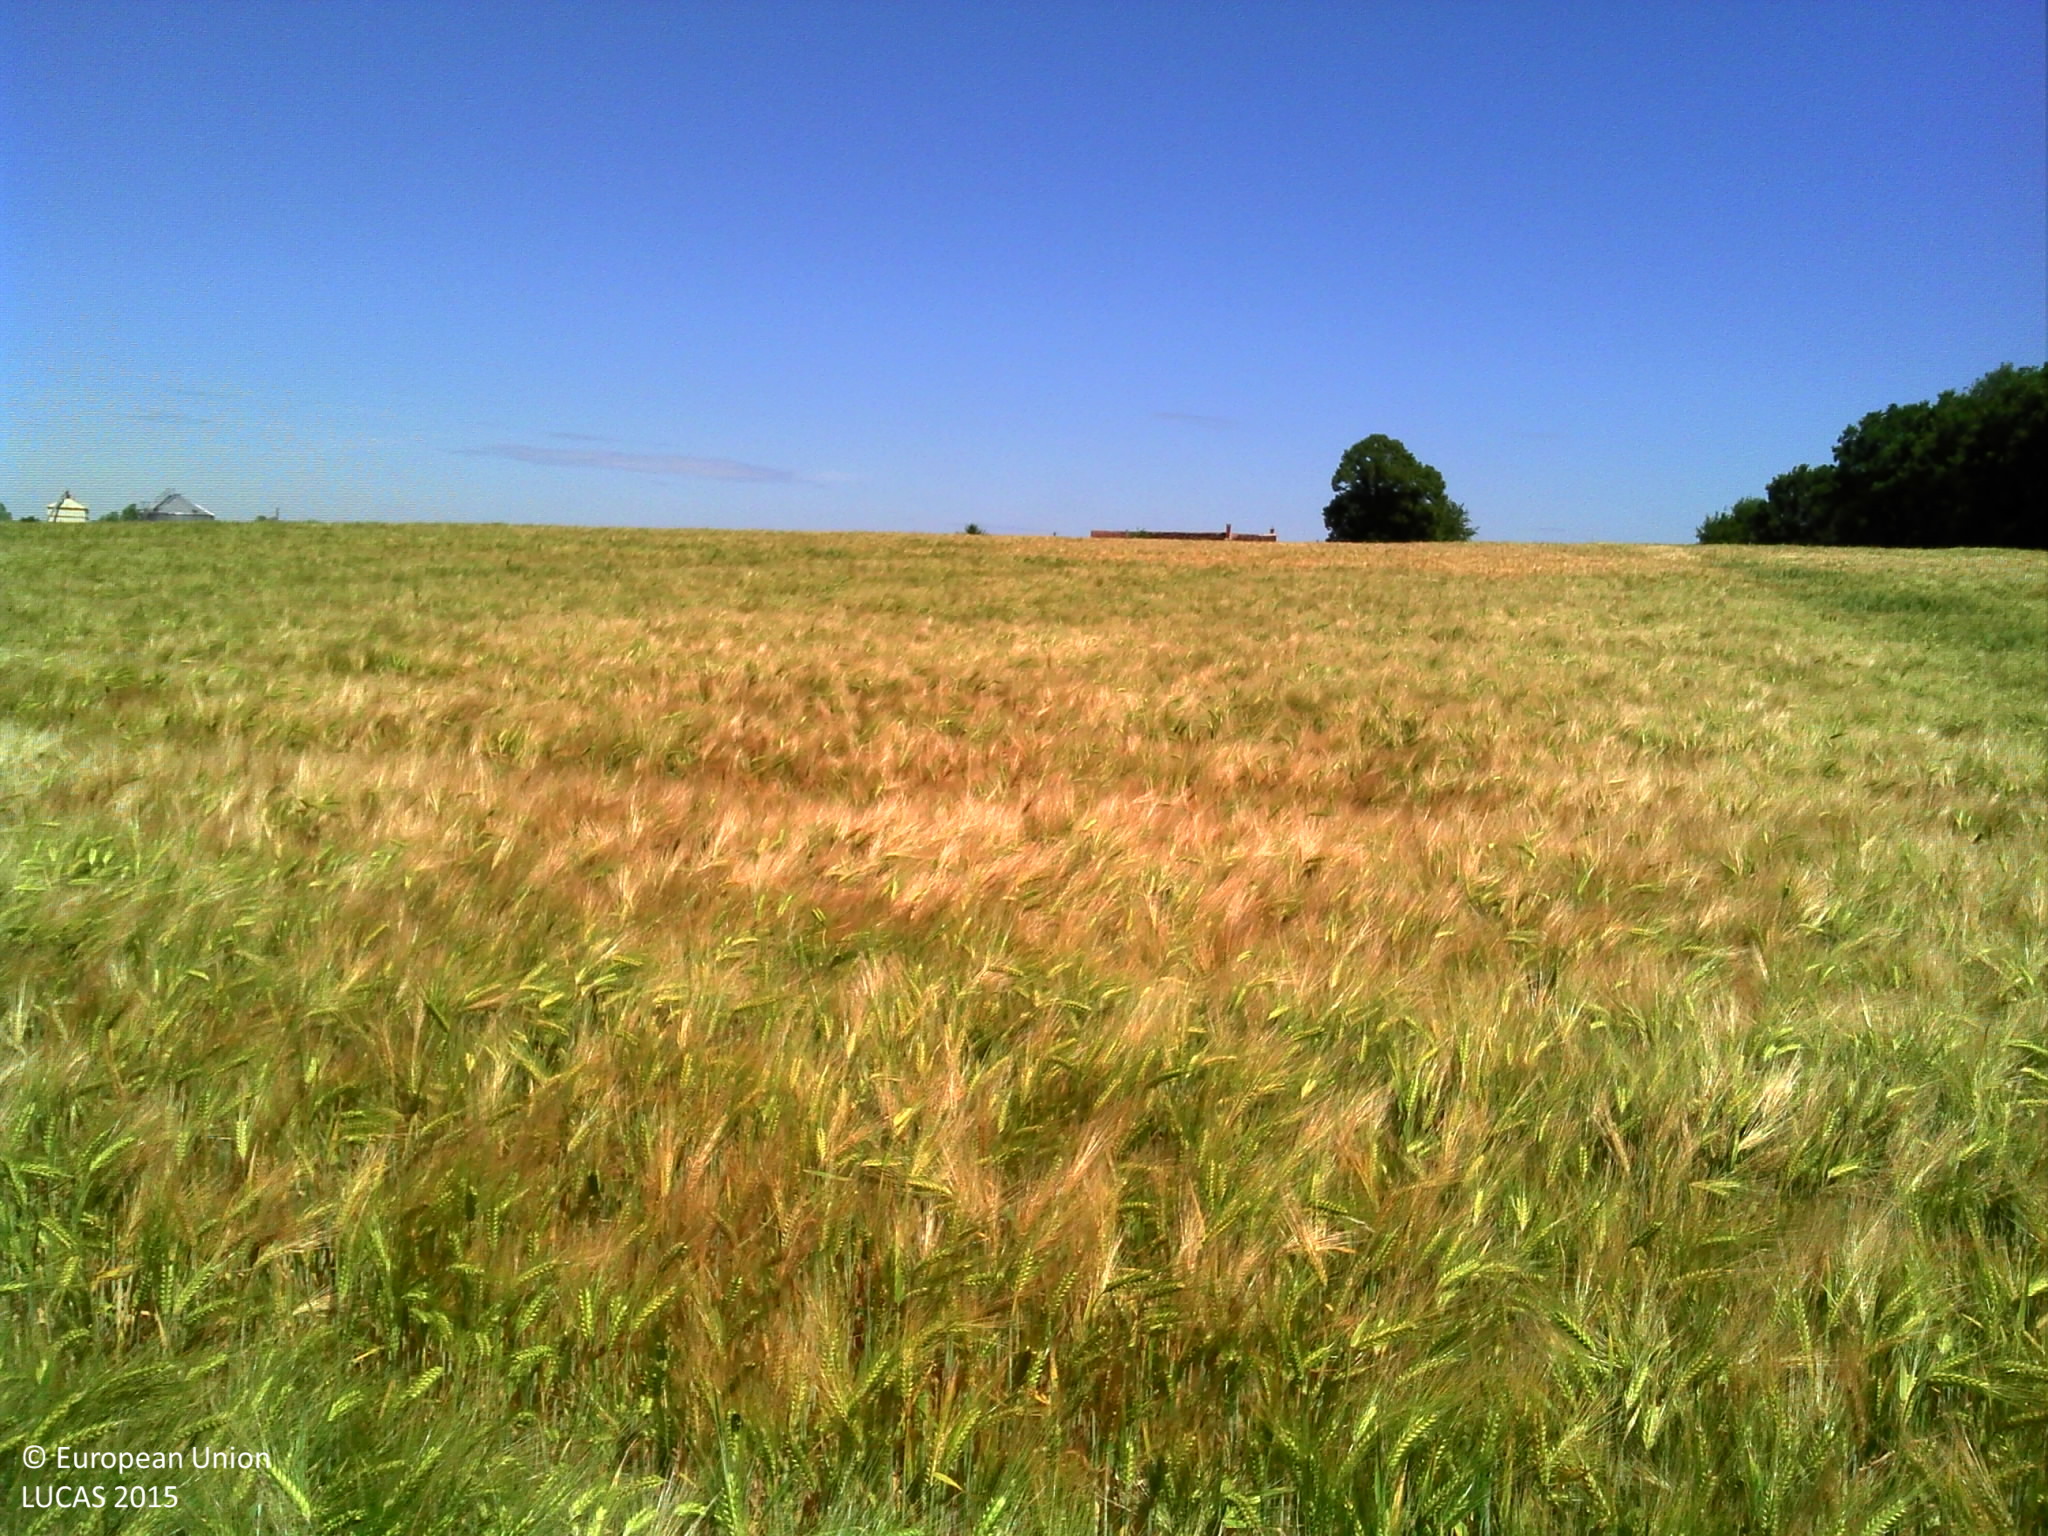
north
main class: Cropland
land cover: Barley
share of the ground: > 75 %
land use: Agriculture (excluding fallow land and kitchen gardens)
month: June
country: FR
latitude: 47.0567
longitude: 2.9256
